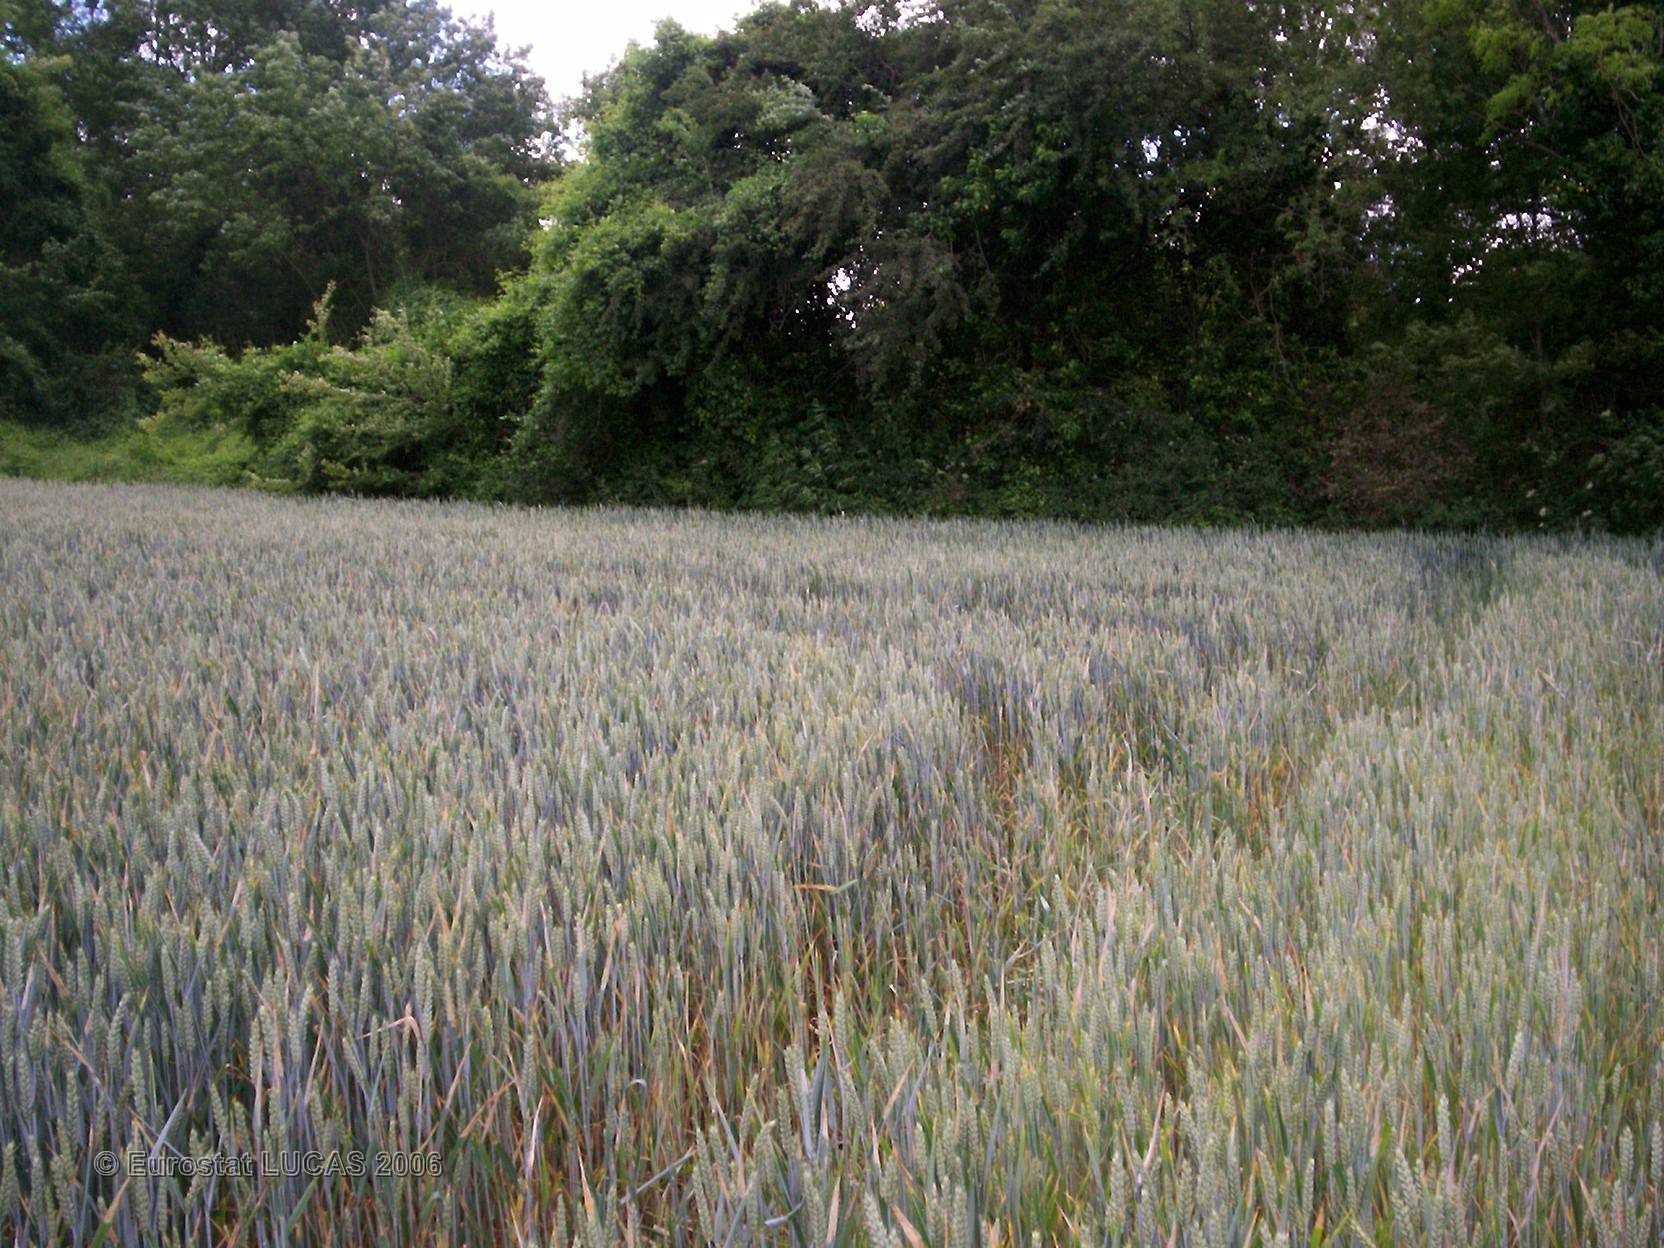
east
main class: Grassland
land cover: Grassland without tree/shrub cover
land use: Agriculture (excluding fallow land and kitchen gardens)
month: May
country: FR
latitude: 43.5039
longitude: 0.9844
